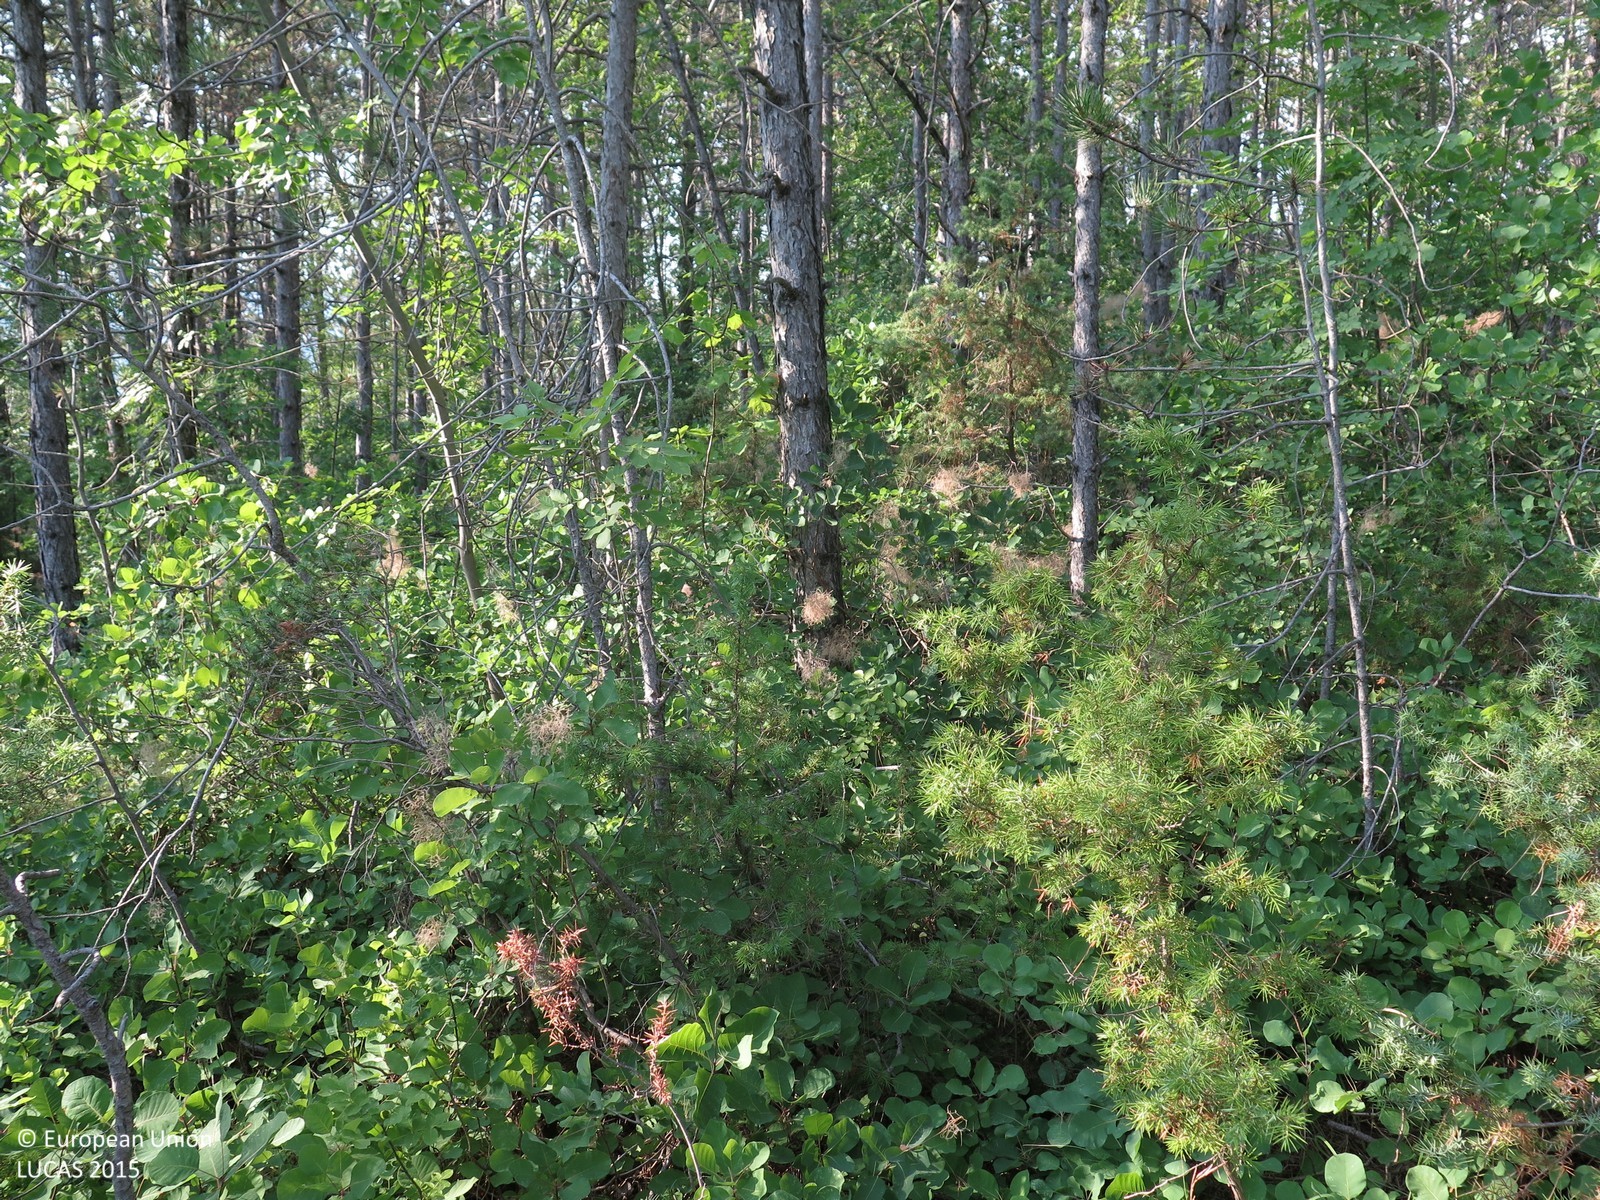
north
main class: Woodland
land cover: Pine dominated coniferous woodland
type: coniferous forest of the mediterranean region
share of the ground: > 75 %
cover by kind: coniferous forest trees 90 %, broadleaved forest trees 5 %, herbaceous plants 5 %
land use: Semi-natural and natural areas not in use
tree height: > 5 m
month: July
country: HR
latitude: 45.2440
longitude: 14.1098
